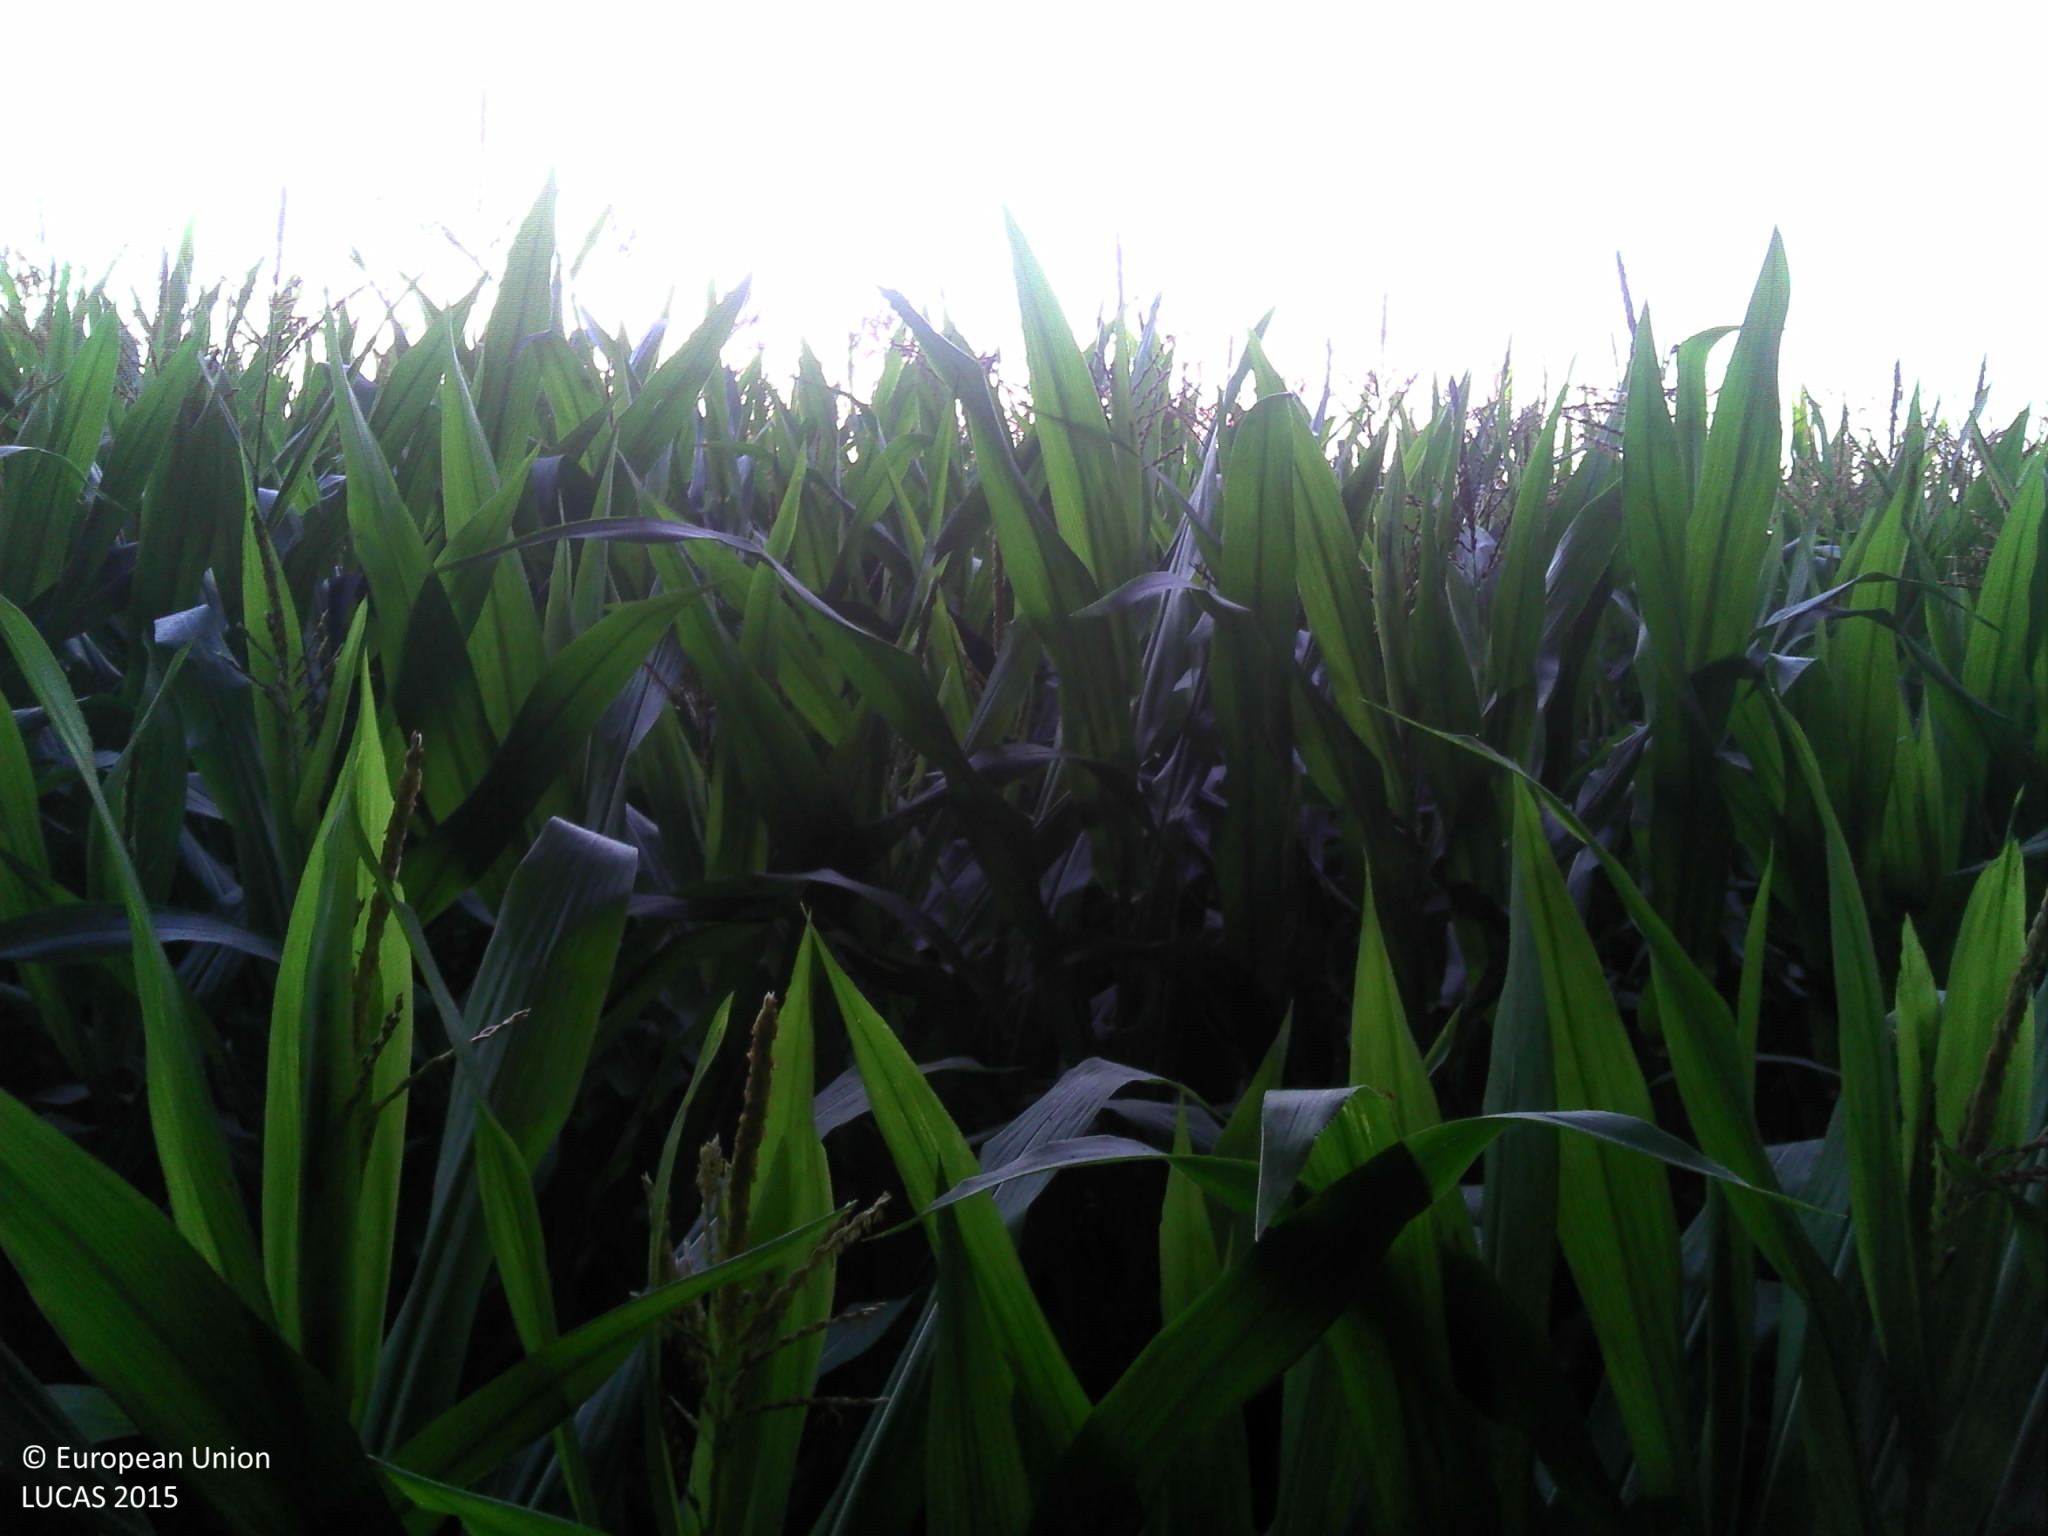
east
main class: Cropland
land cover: Maize
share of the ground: > 75 %
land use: Agriculture (excluding fallow land and kitchen gardens)
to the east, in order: Maize; Electric lines; Maize; Lines of trees; Ditches and canals; Artificial constructions in urban areas
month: August
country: BE
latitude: 51.1199
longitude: 5.0111
